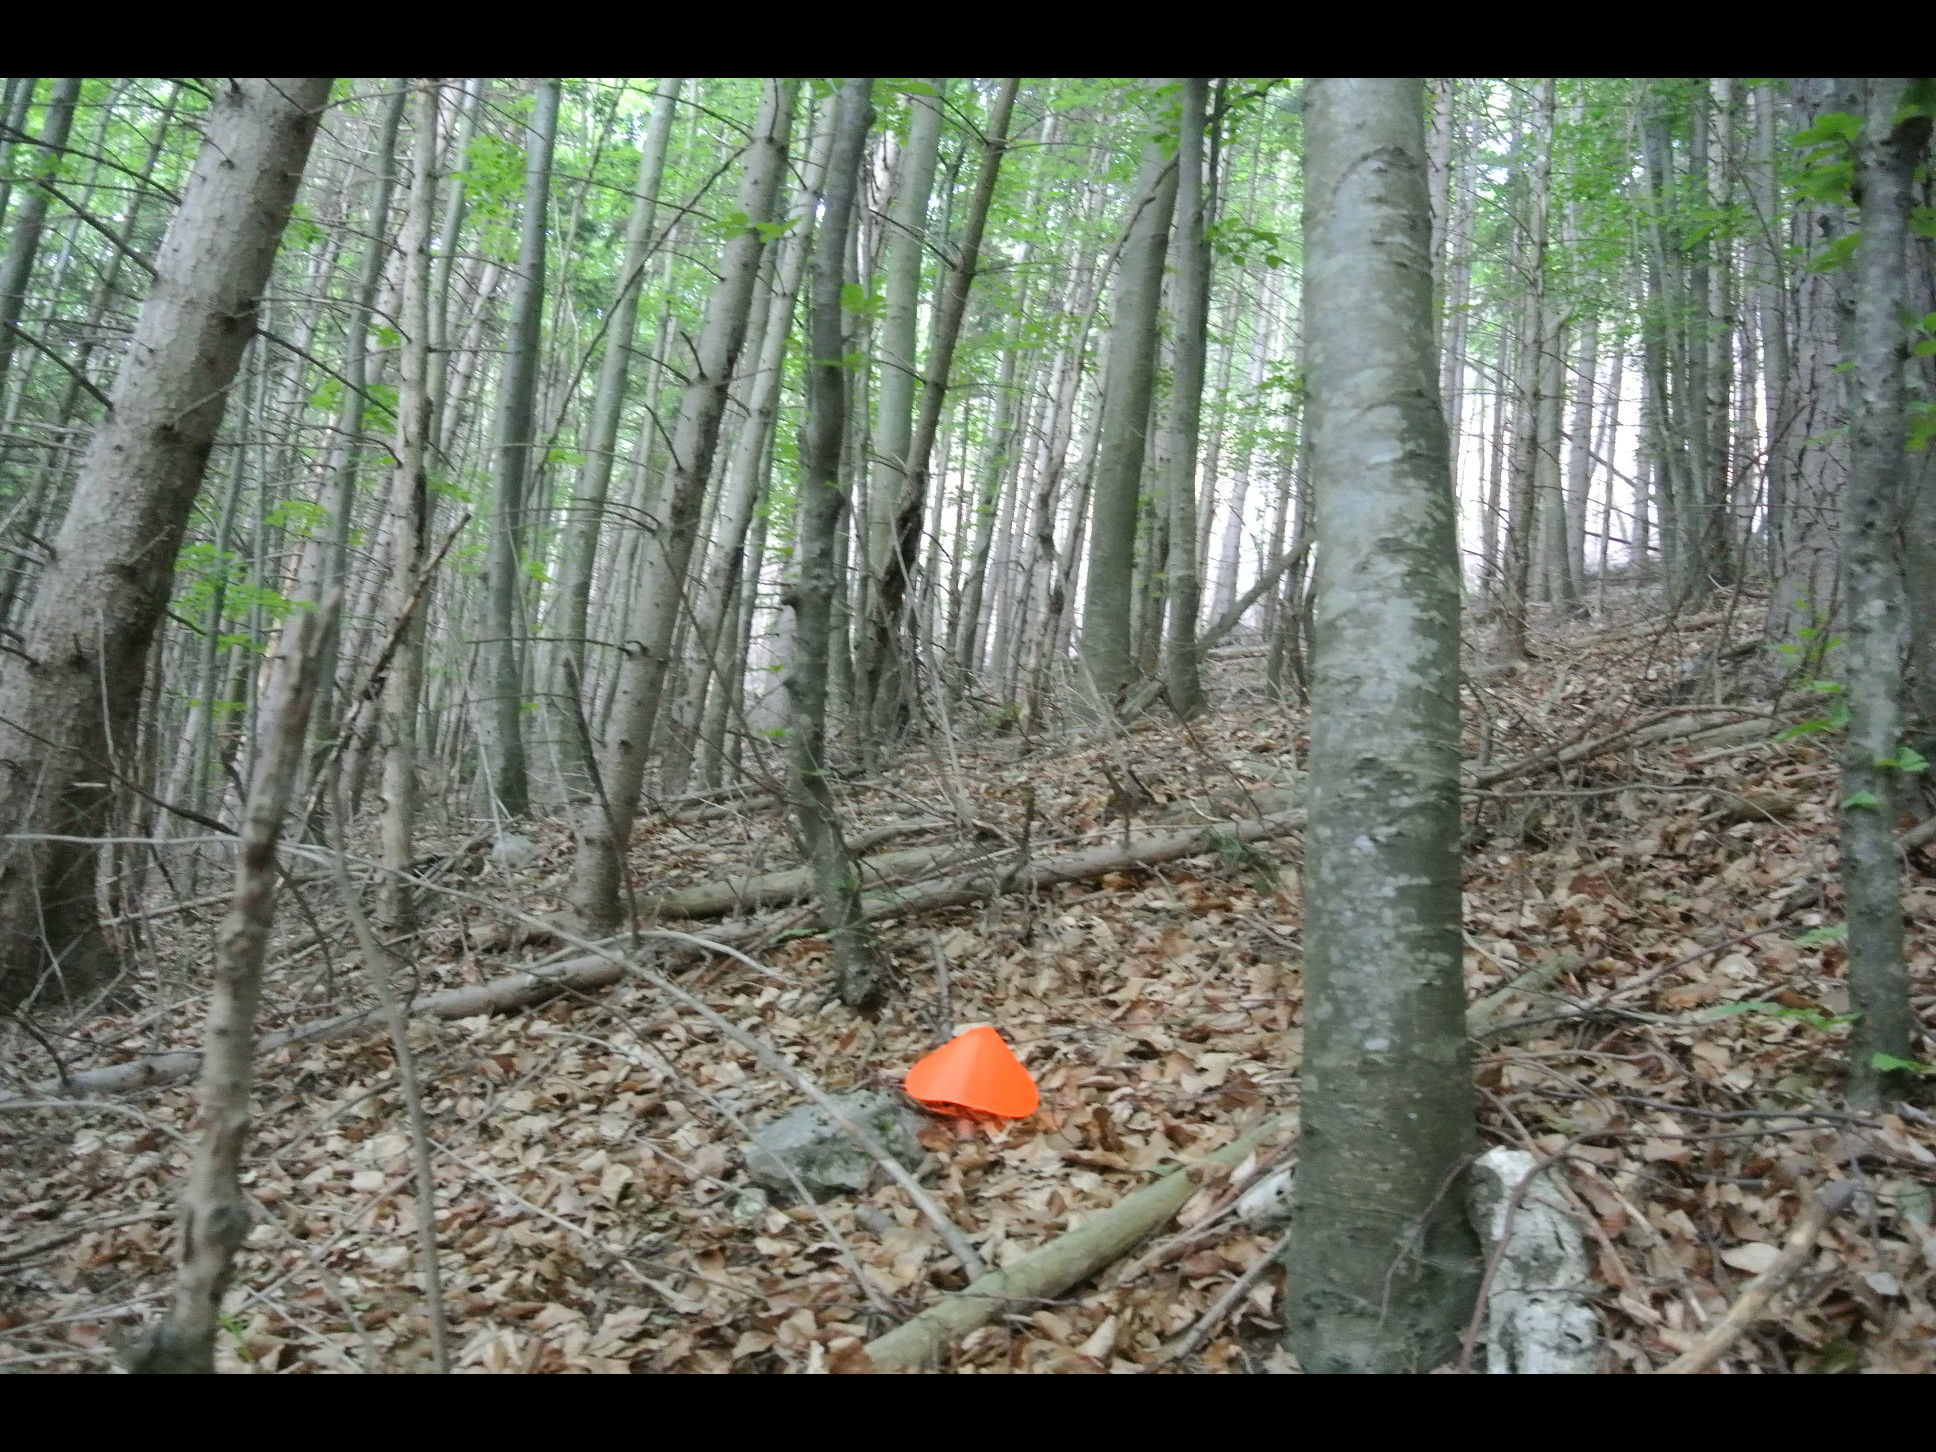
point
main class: Woodland
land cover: Broadleaved woodland
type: beech forest
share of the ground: > 75 %
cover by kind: broadleaved forest trees 100 %
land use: Forestry
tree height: > 5 m
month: May
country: AT
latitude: 47.7100
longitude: 15.7999
